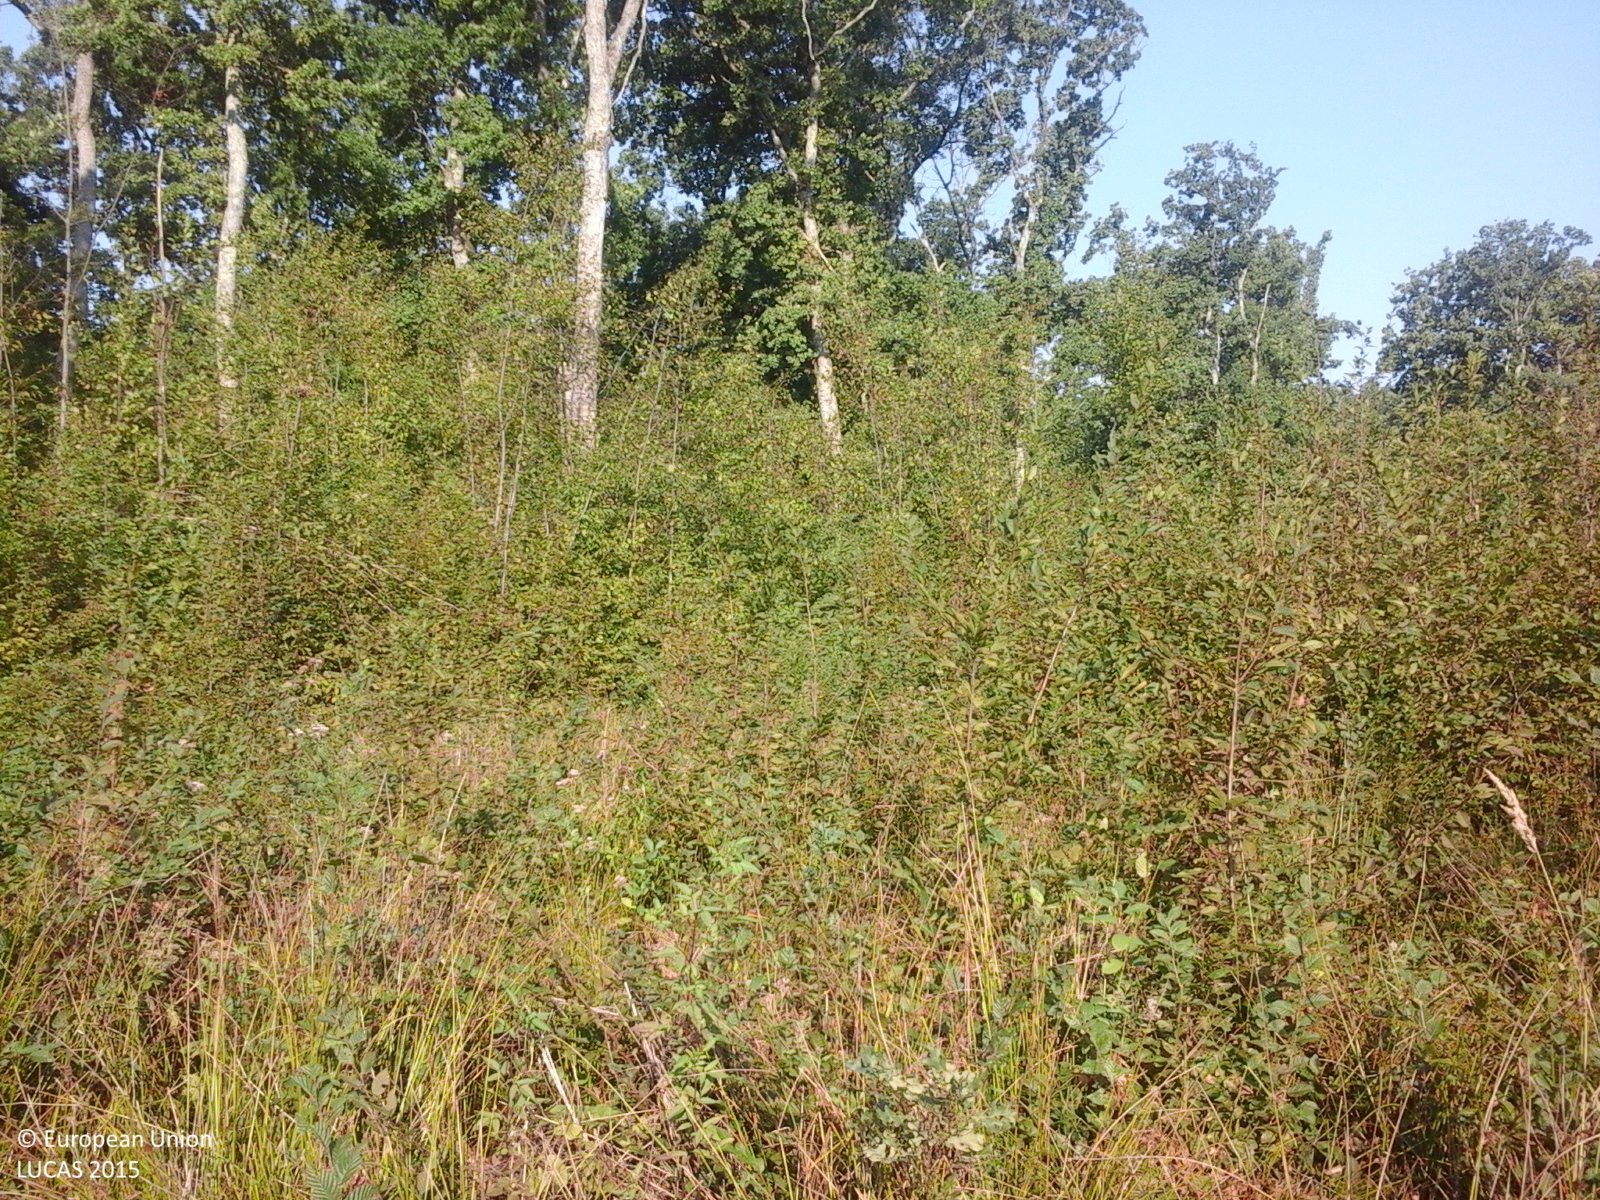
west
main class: Shrubland
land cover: Shrubland with sparse tree cover
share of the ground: > 75 %
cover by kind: herbaceous plants 75 %, shrubs 20 %, broadleaved forest trees 5 %
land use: Forestry
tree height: < 5 m
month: August
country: RO
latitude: 46.4192
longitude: 22.1593
